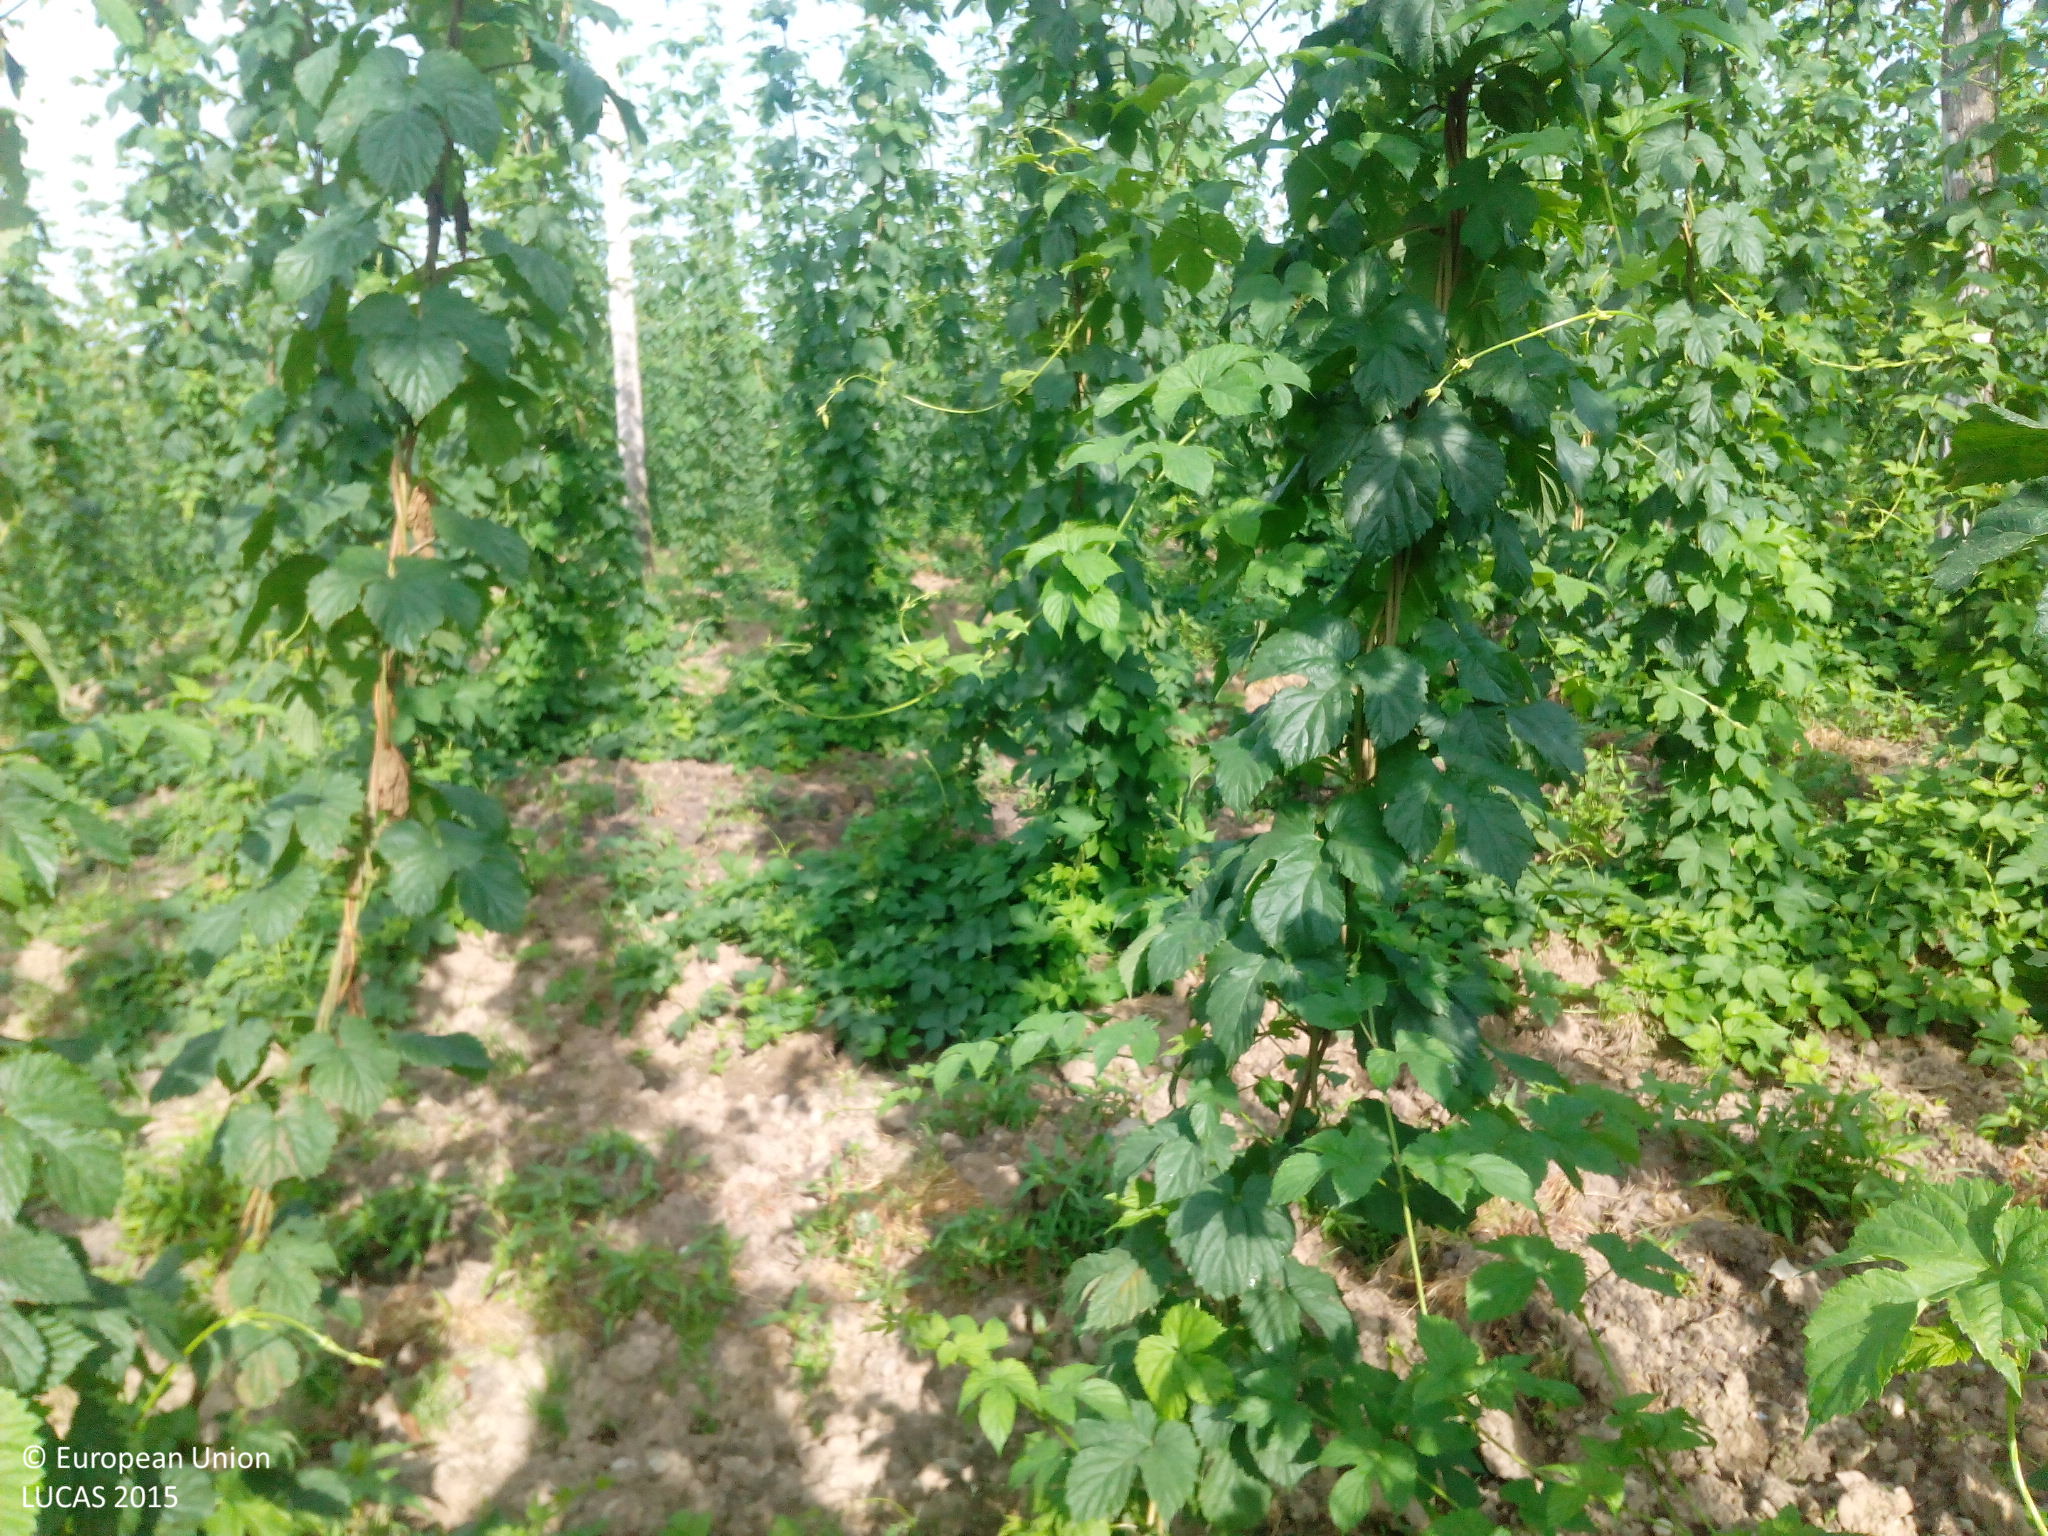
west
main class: Cropland
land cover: Other non-permanent industrial crops
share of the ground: > 75 %
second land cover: Spontaneously vegetated surfaces
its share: < 10 %
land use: Agriculture (excluding fallow land and kitchen gardens)
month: June
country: DE
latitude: 47.6651
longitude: 9.6674
